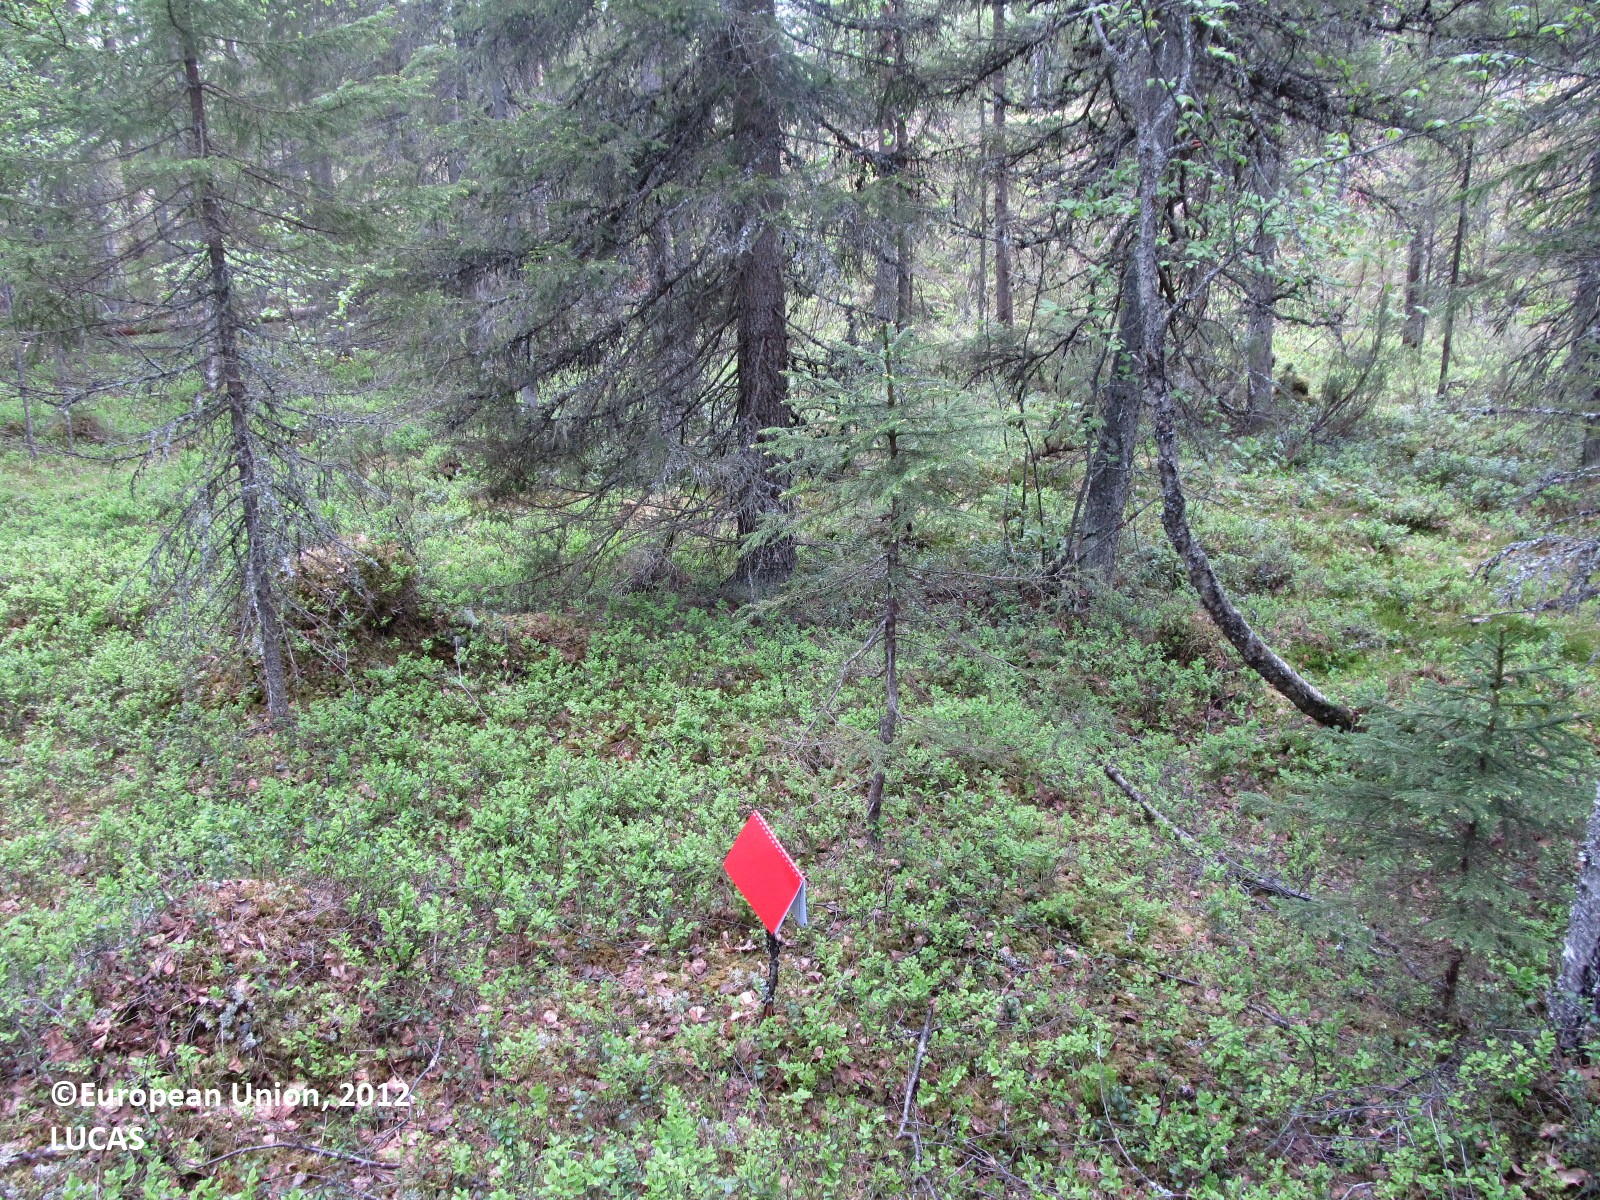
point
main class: Woodland
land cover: Spruce dominated coniferous woodland
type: boreal forest
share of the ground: 50 - 75 %
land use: Forestry
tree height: > 5 m
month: June
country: FI
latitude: 63.2592
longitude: 29.0783
